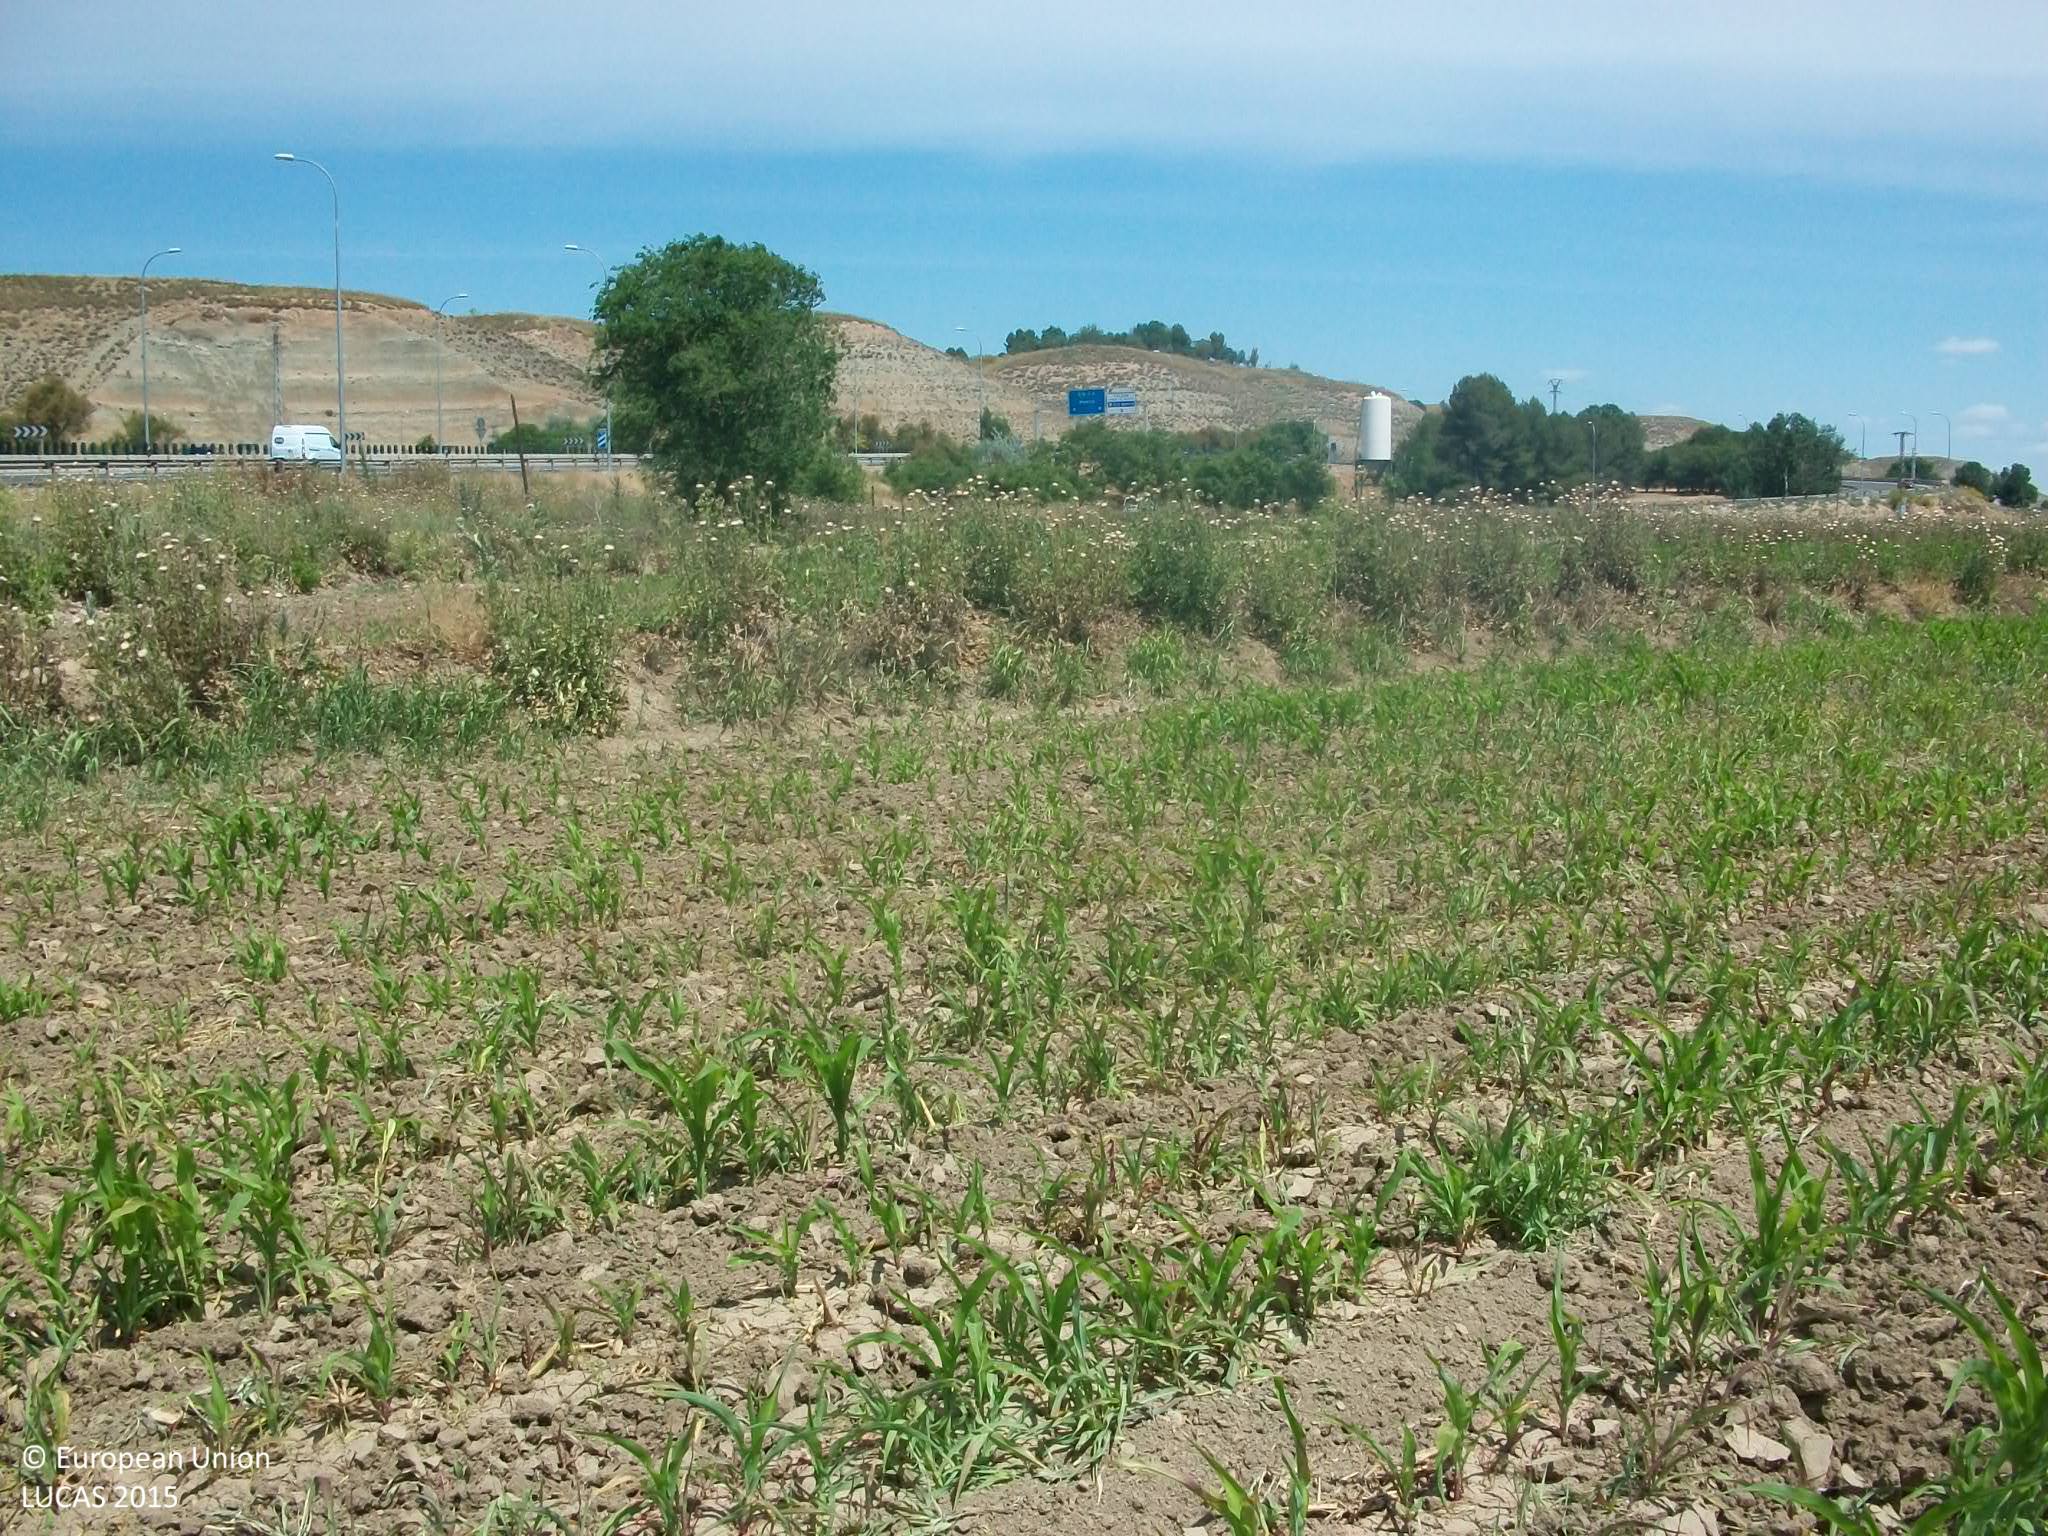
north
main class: Cropland
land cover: Maize
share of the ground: 50 - 75 %
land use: Agriculture (excluding fallow land and kitchen gardens)
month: May
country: ES
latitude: 40.0394
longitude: -3.6624
